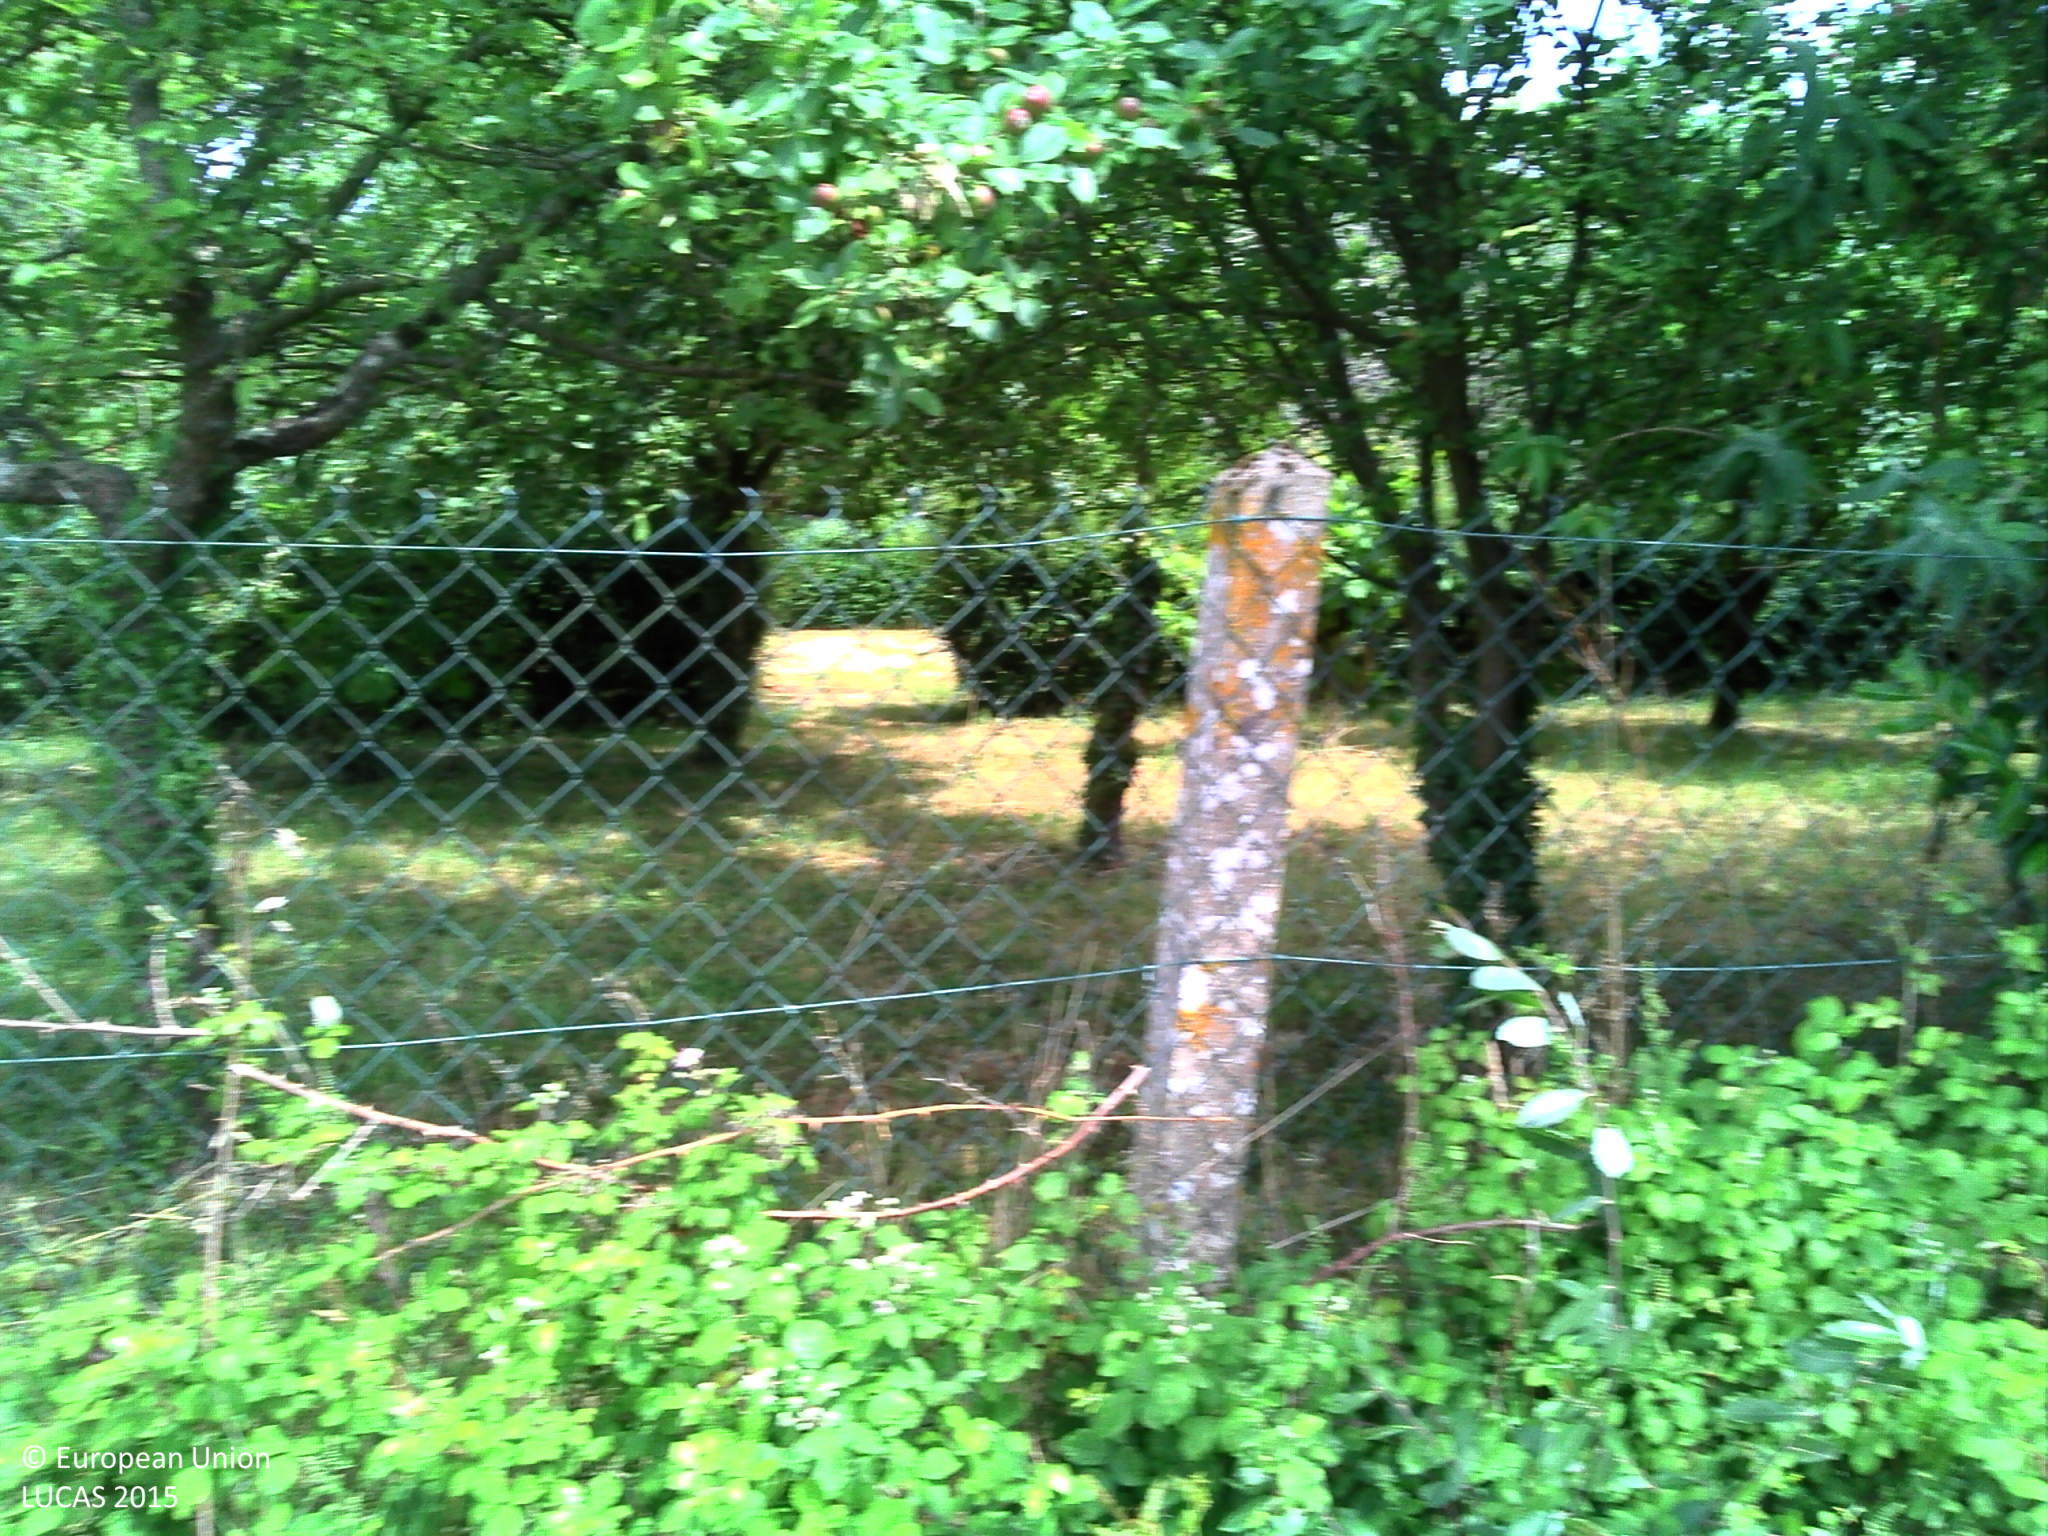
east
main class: Cropland
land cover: Apple fruit
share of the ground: > 75 %
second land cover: Grassland without tree/shrub cover
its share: > 75 %
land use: Kitchen garden
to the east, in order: Apple fruit; Grassland without tree/shrub cover; Artificial constructions in urban areas; Grassland without tree/shrub cover; Apple fruit
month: June
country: FR
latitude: 47.9552
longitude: -1.9286
